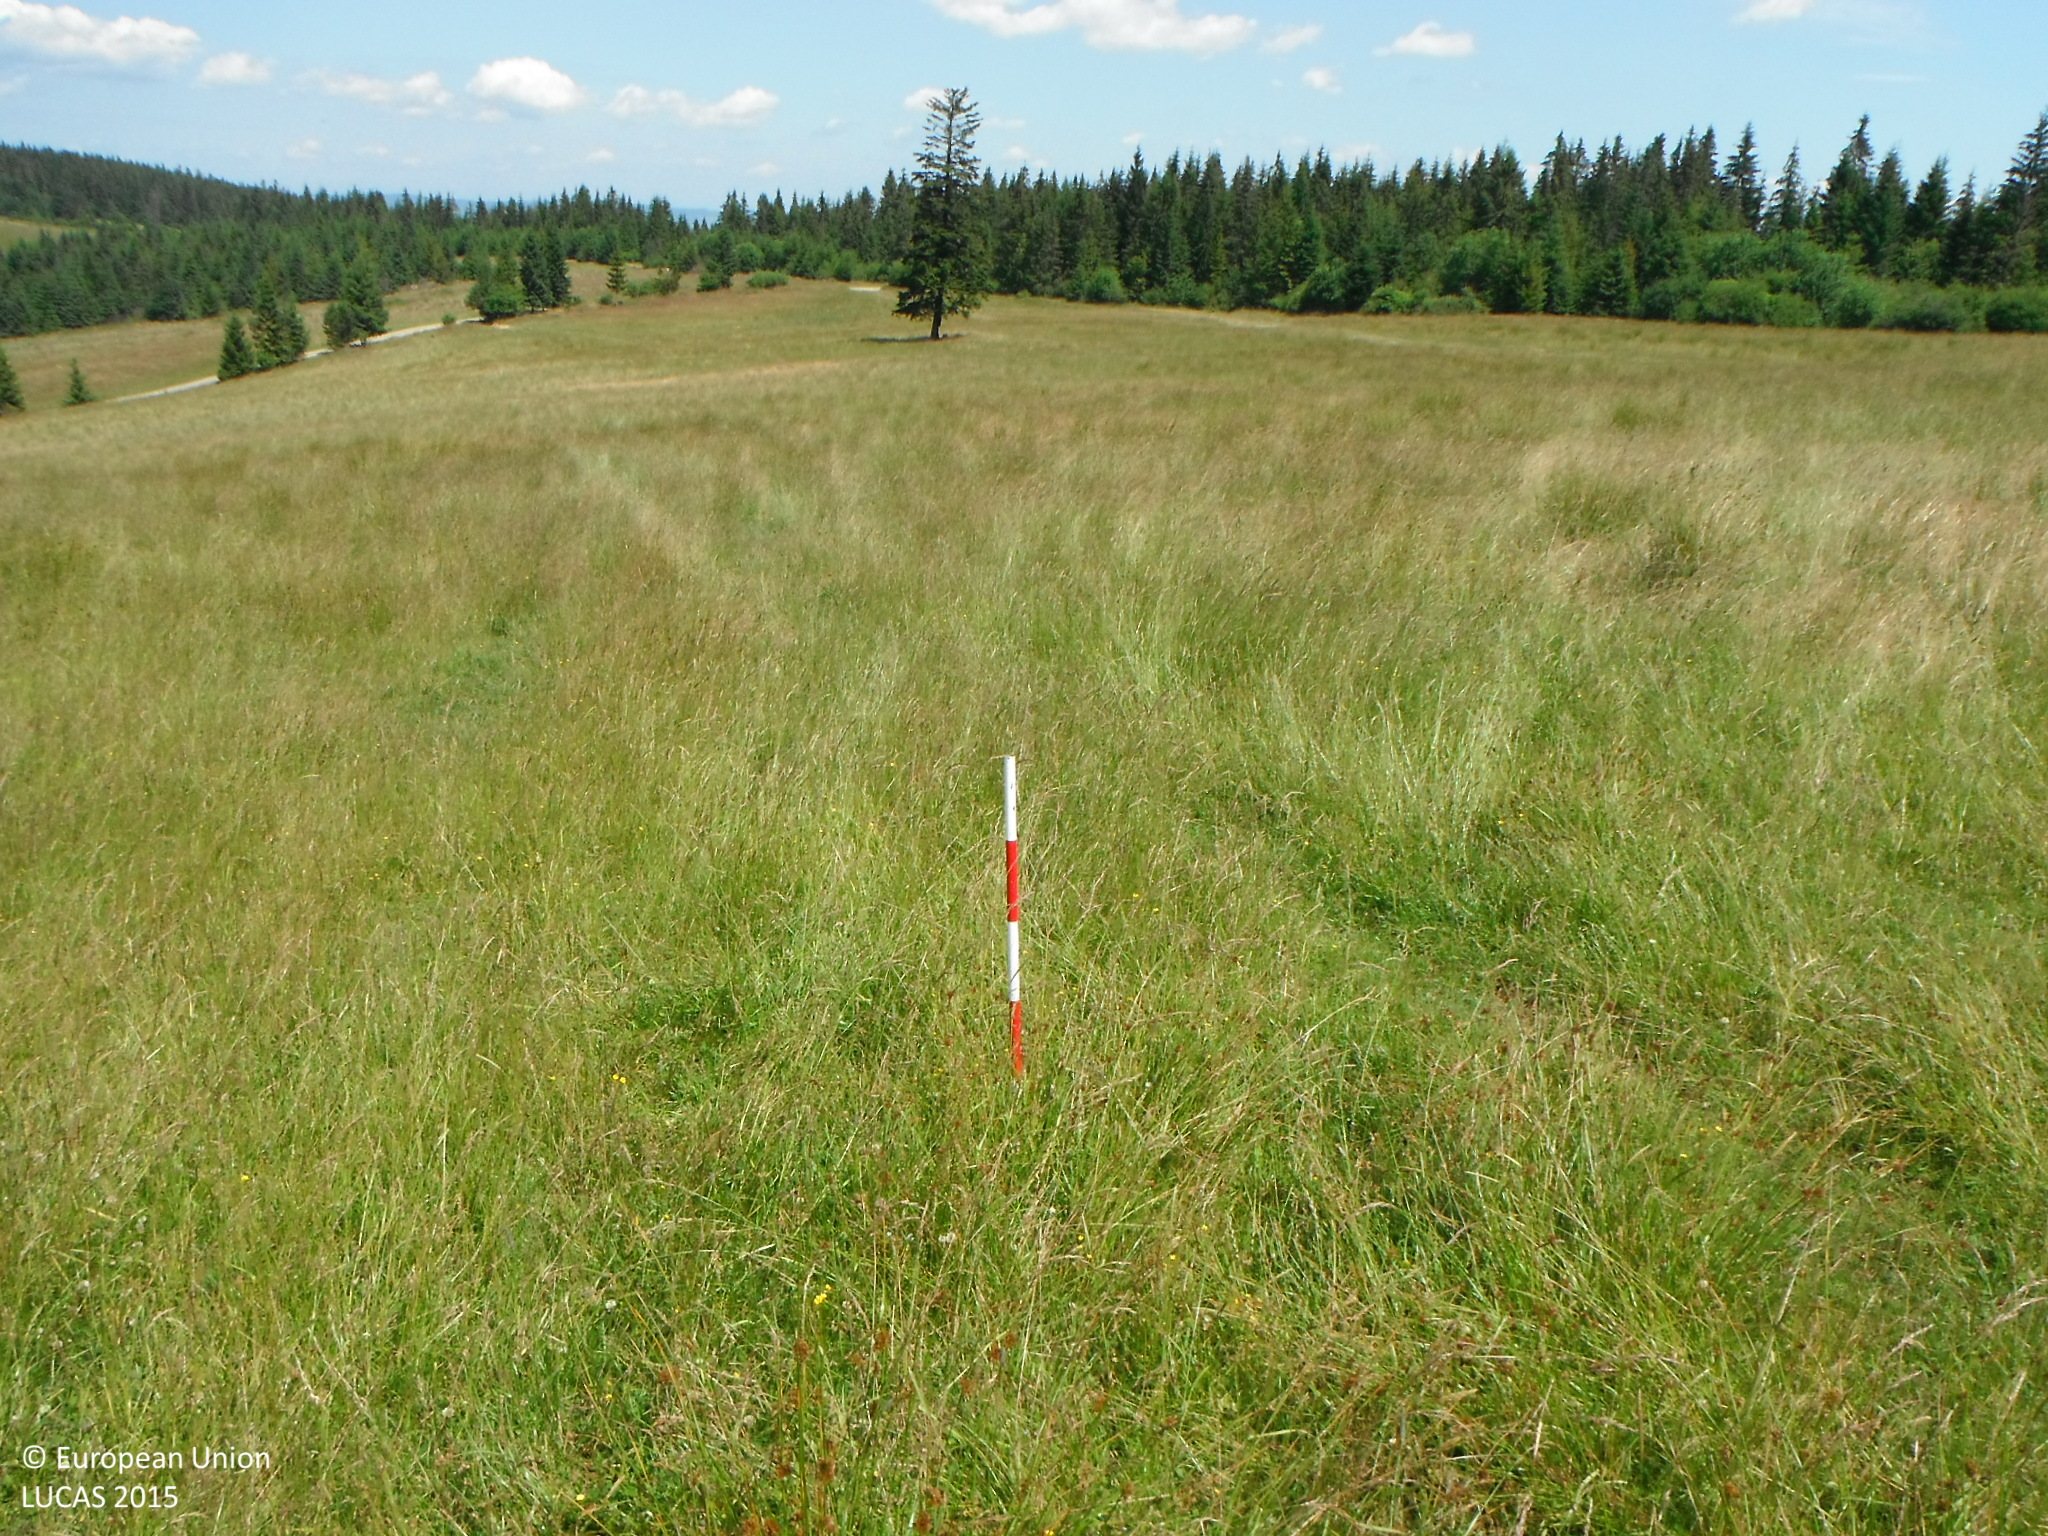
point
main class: Grassland
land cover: Grassland without tree/shrub cover
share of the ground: > 75 %
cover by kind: herbaceous plants 100 %
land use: Agriculture (excluding fallow land and kitchen gardens)
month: July
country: SK
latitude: 49.3300
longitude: 19.7573
